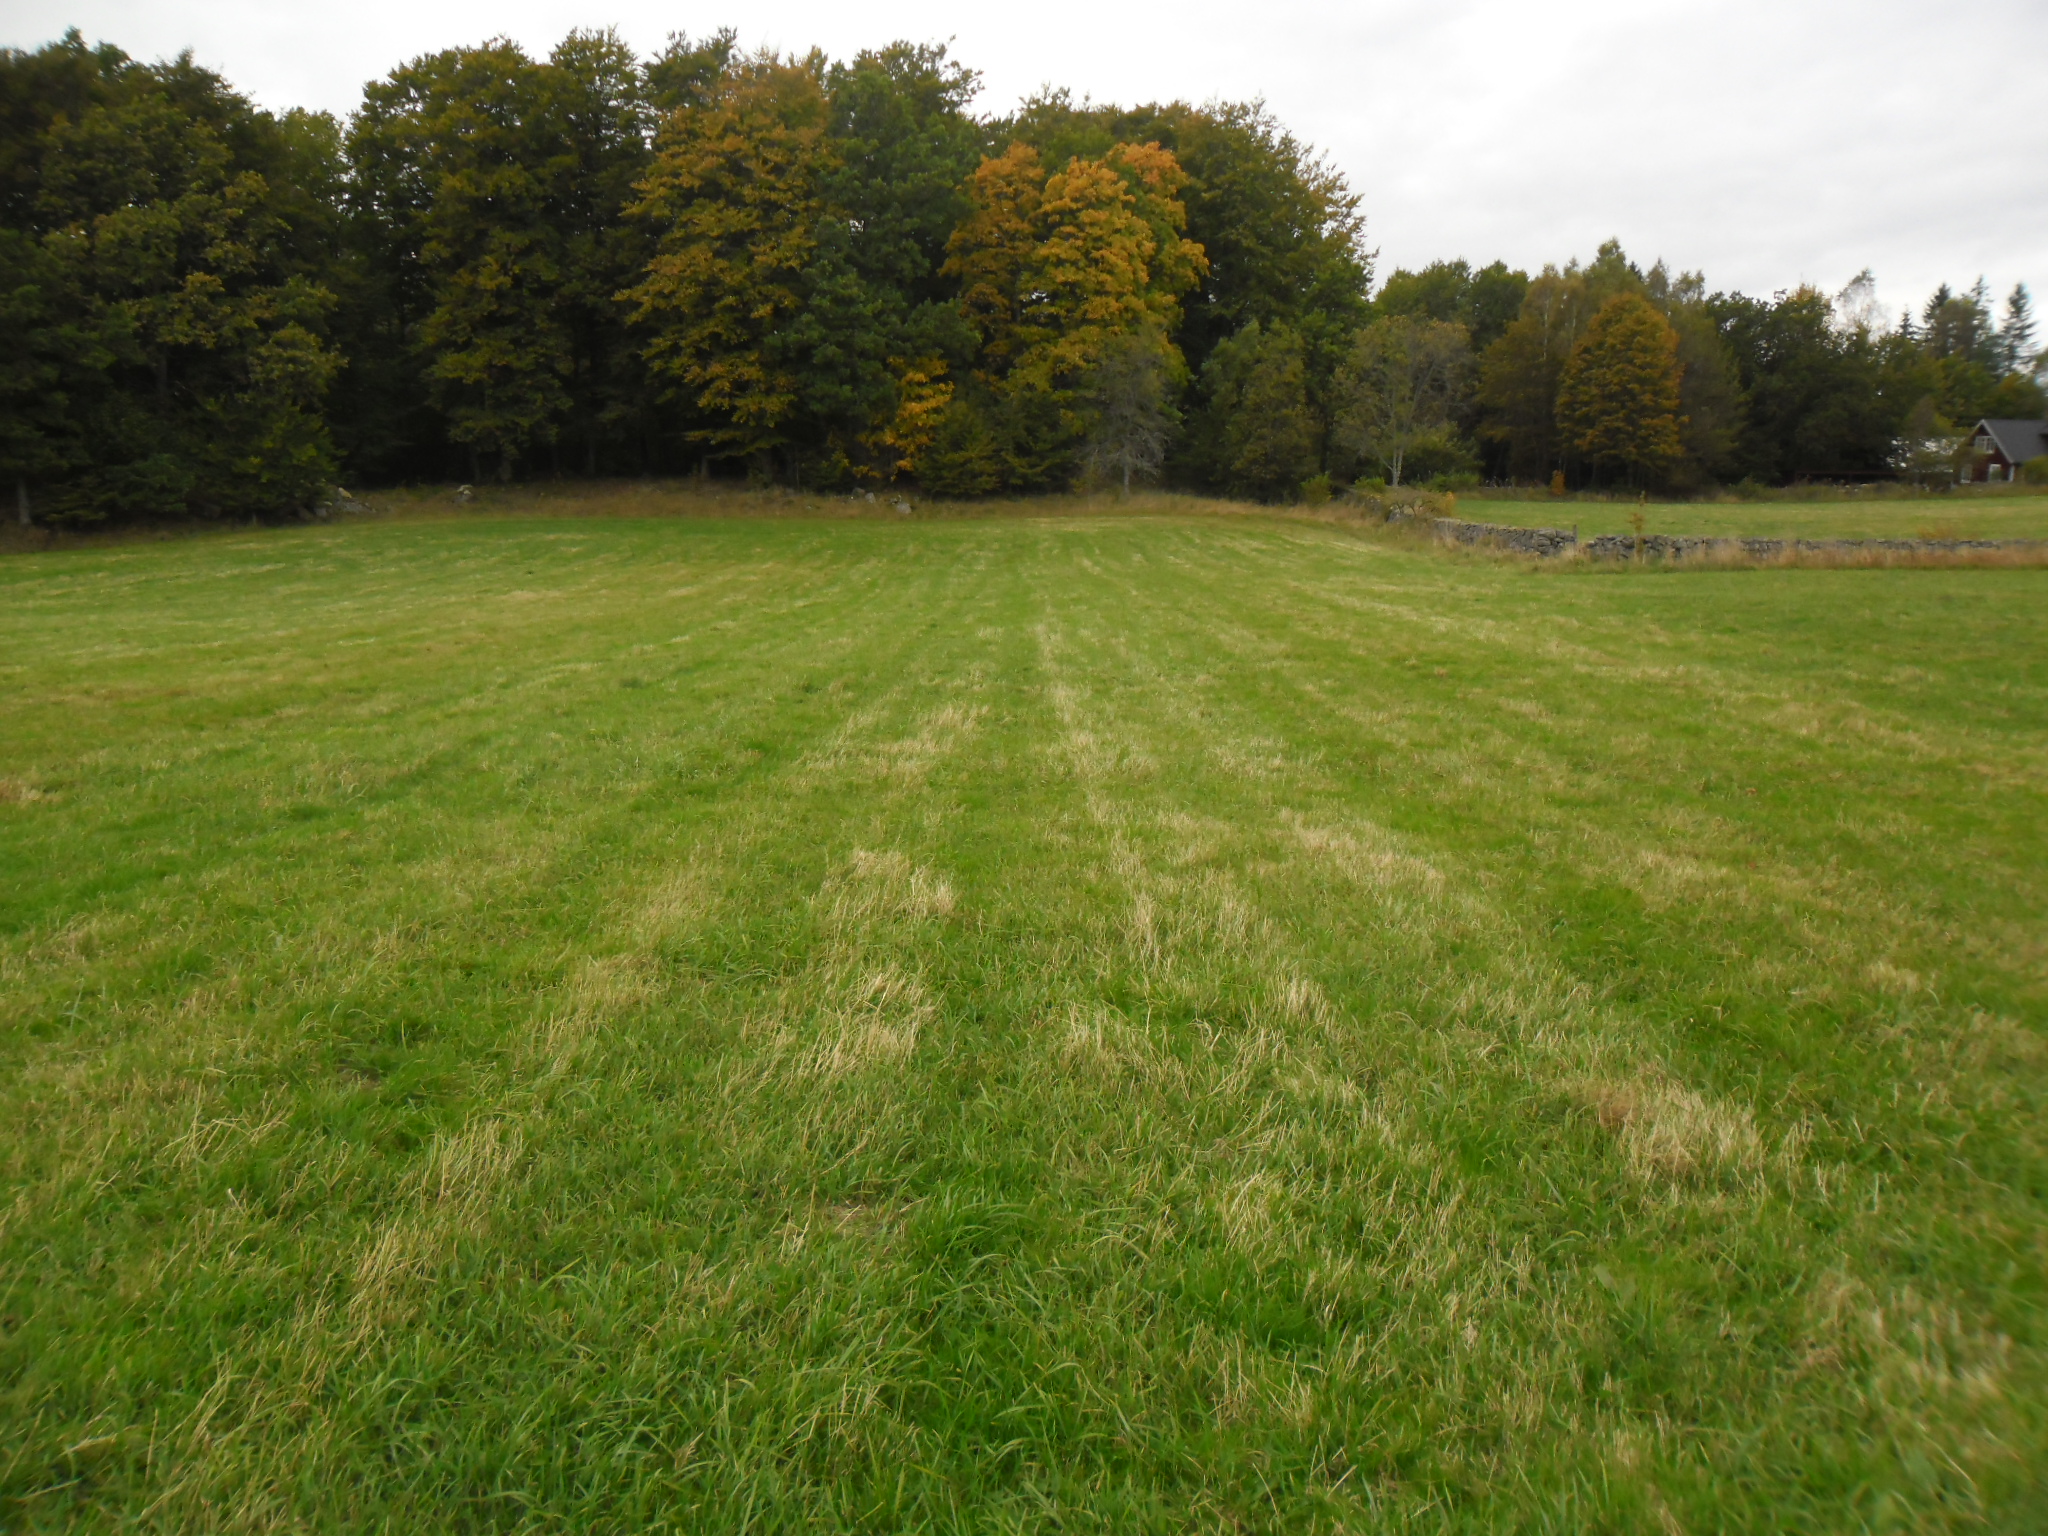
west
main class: Grassland
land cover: Grassland without tree/shrub cover
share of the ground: > 75 %
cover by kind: herbaceous plants 100 %
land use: Agriculture (excluding fallow land and kitchen gardens)
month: October
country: SE
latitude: 56.3315
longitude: 13.7334
